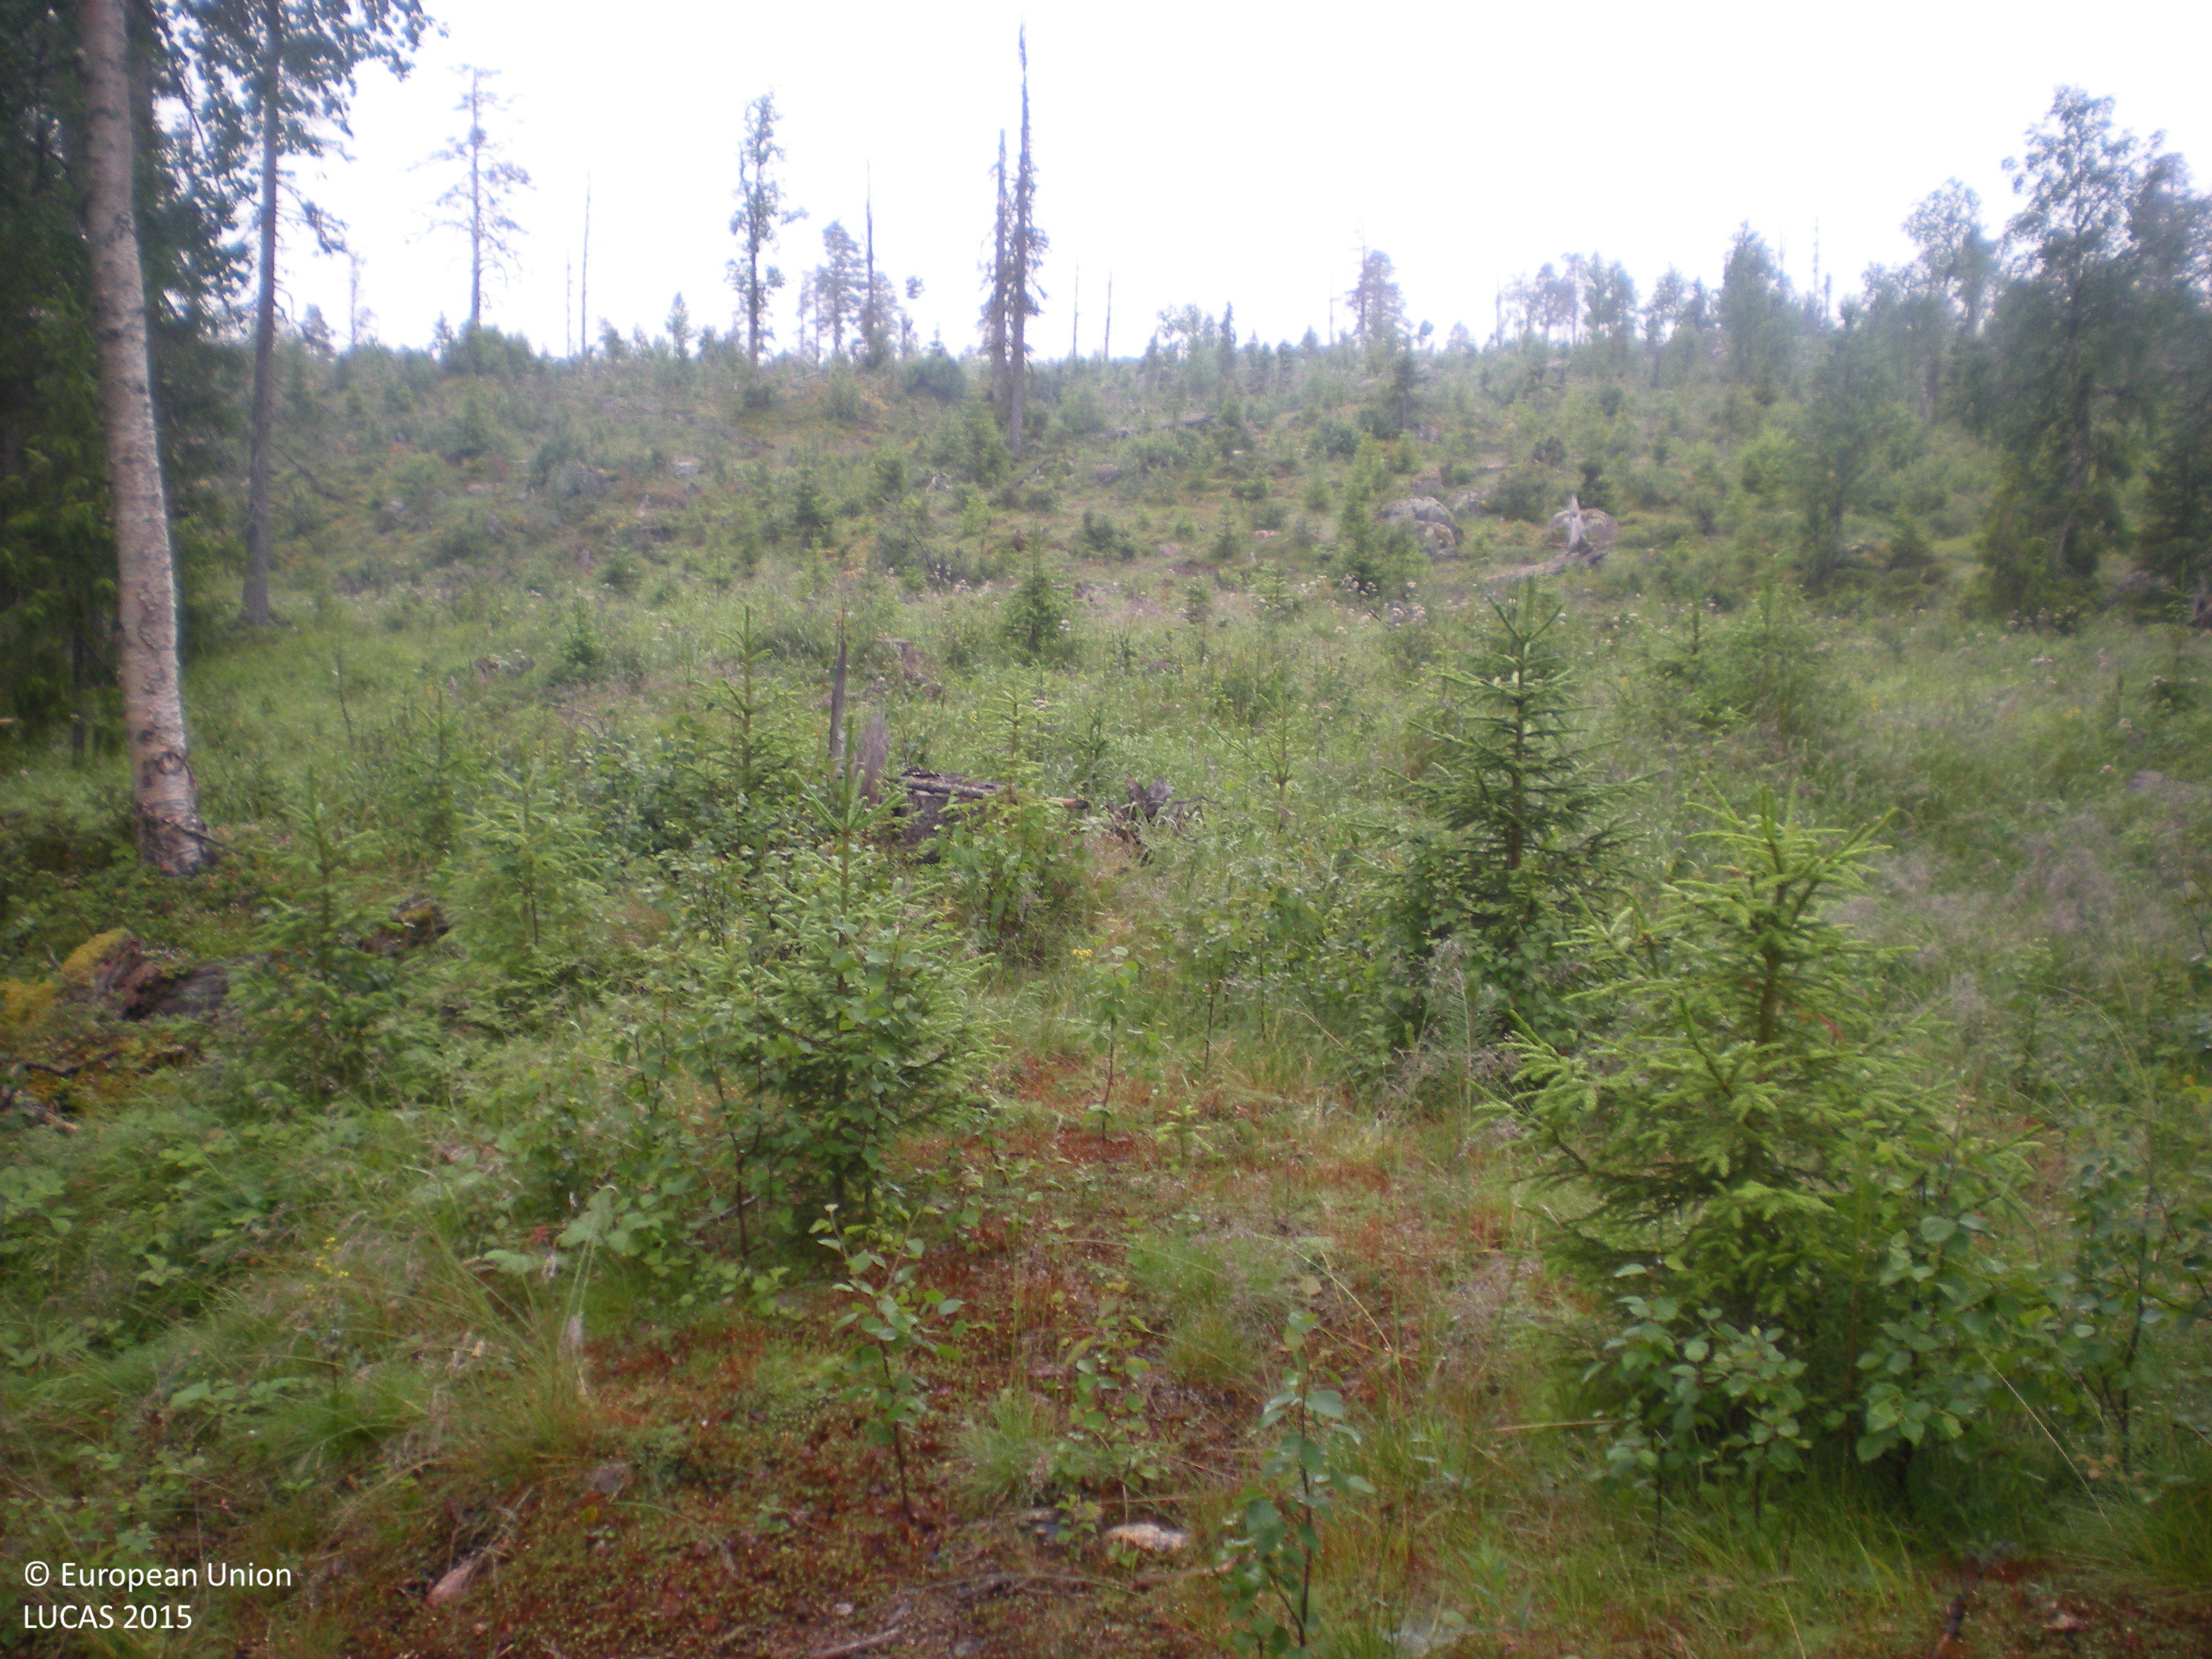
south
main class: Woodland
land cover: Spruce dominated mixed woodland
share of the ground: 50 - 75 %
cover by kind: coniferous forest trees 40 %, shrubs 25 %, broadleaved forest trees 20 %, lichens and mosses 10 %, herbaceous plants 5 %
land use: Forestry
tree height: > 5 m
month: August
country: SE
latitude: 66.0910
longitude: 18.2910
